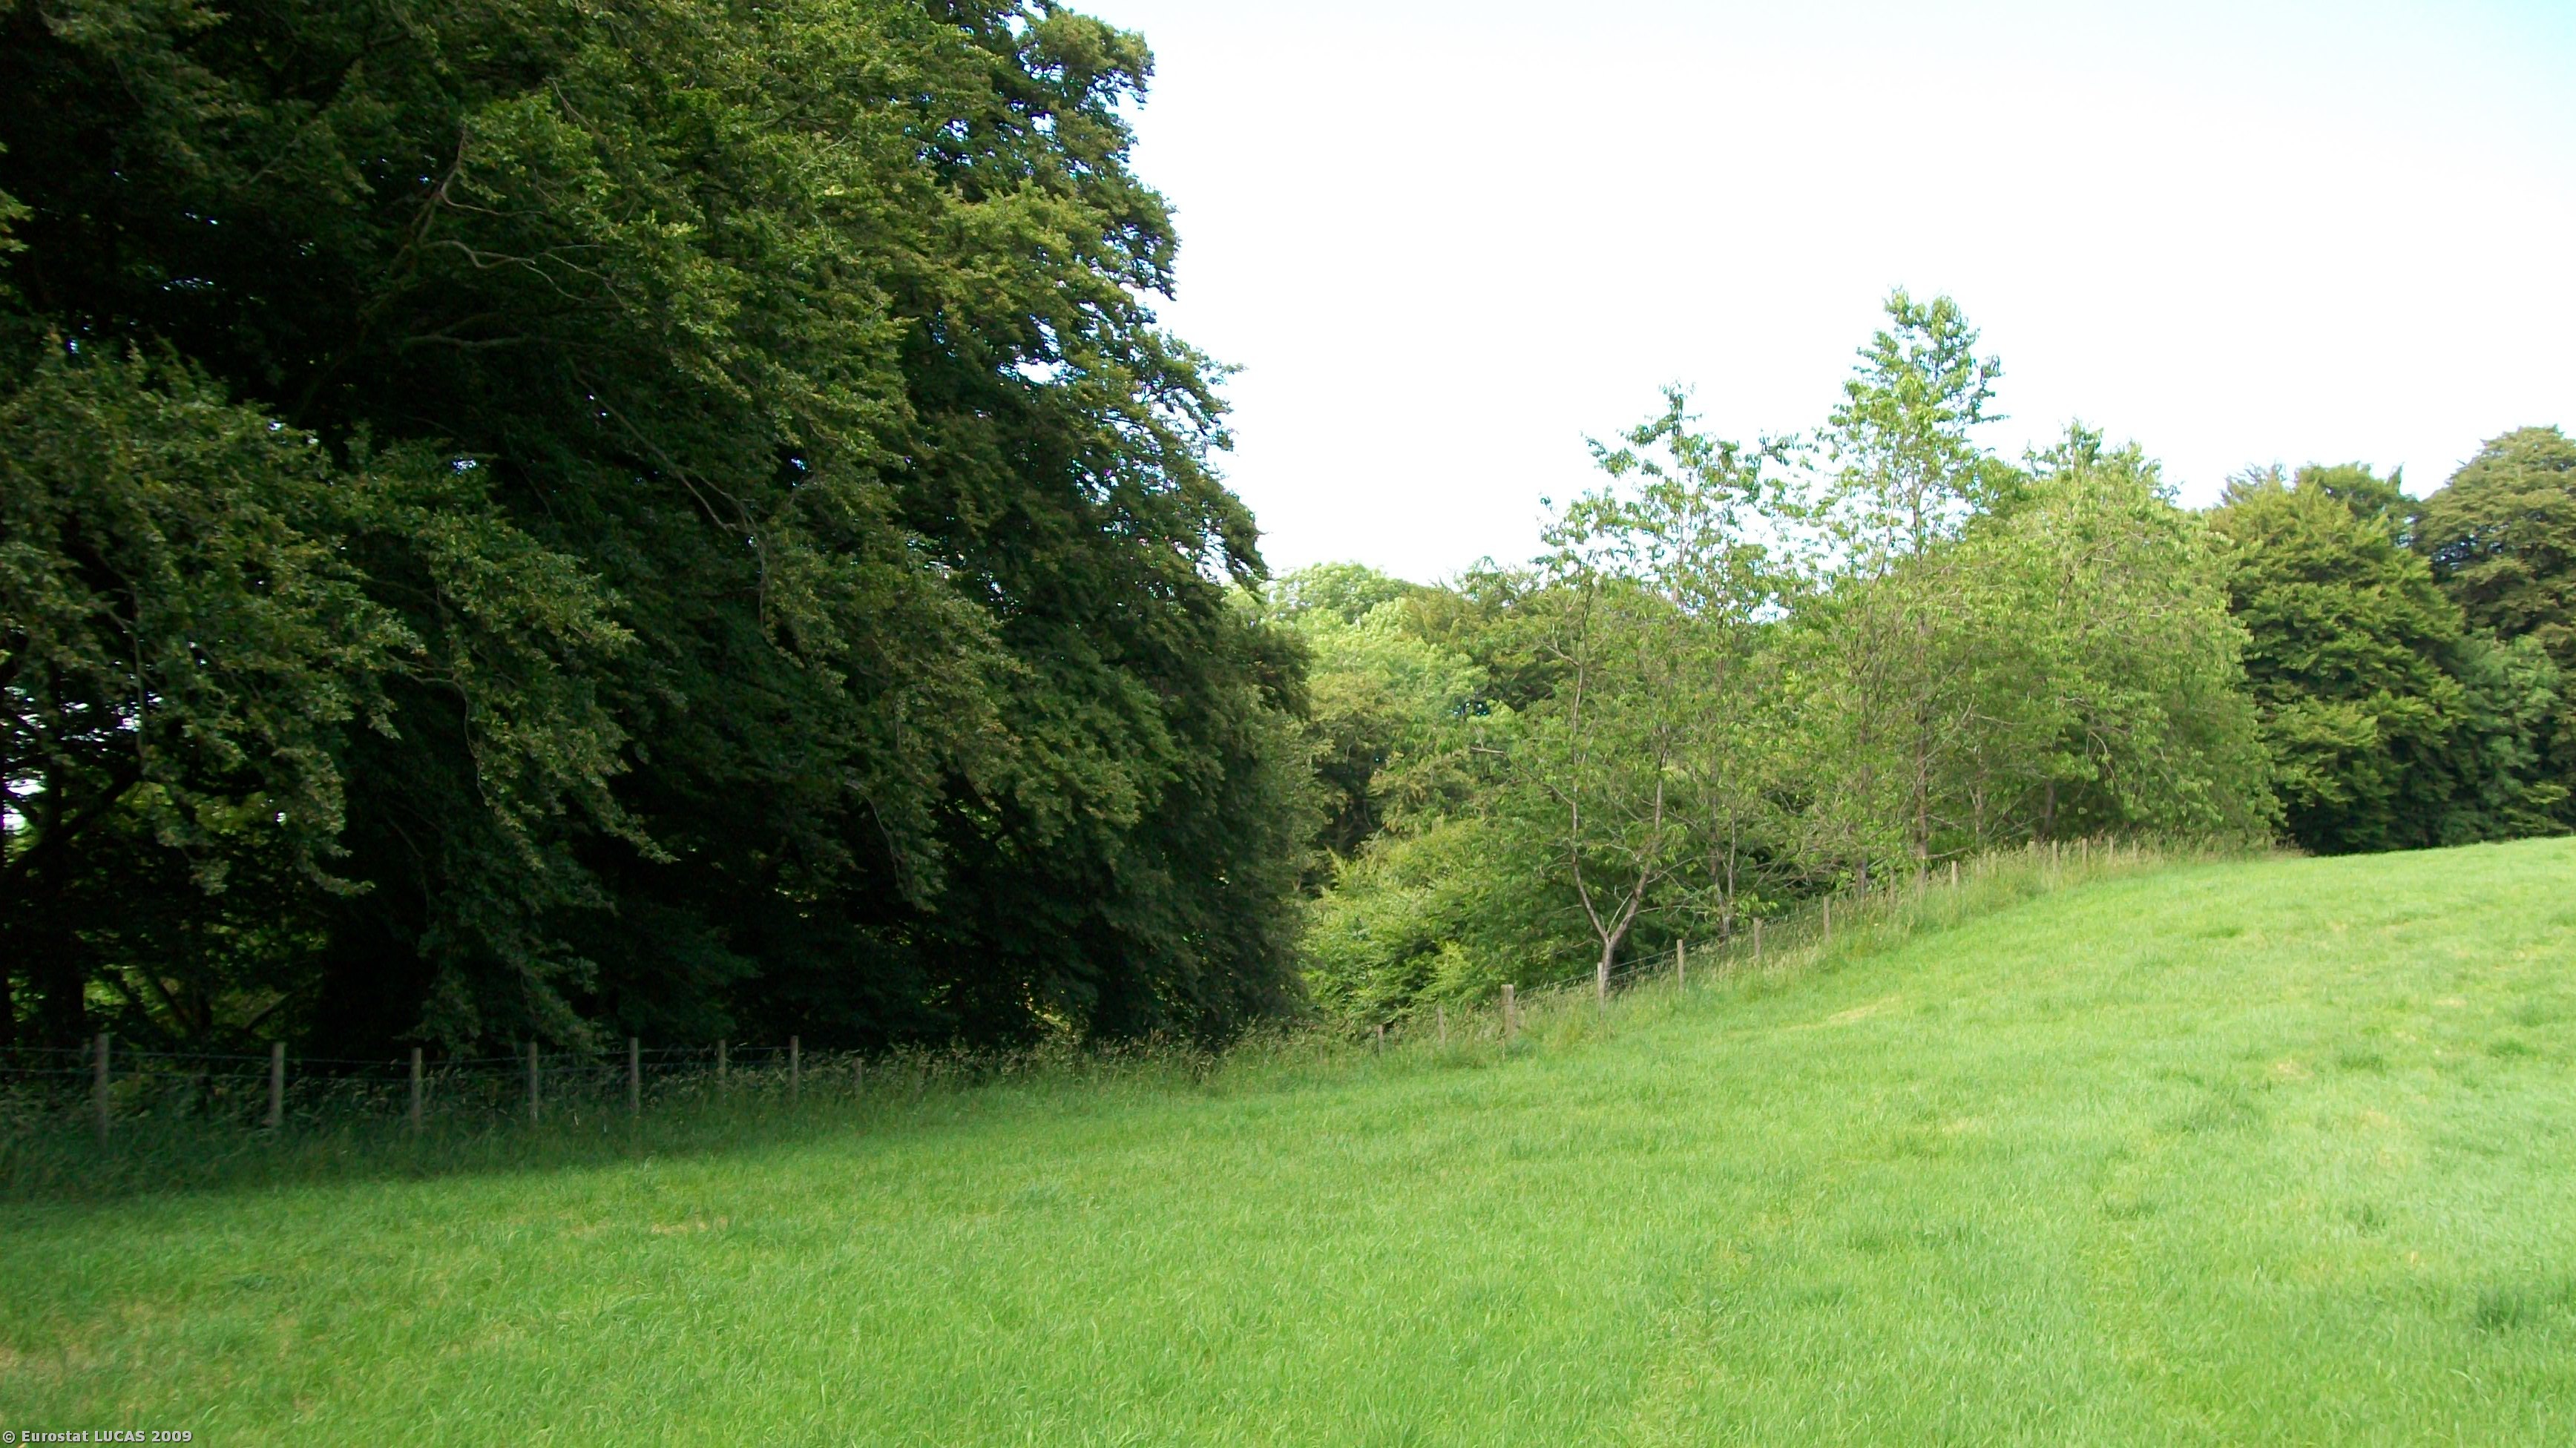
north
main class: Grassland
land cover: Grassland without tree/shrub cover
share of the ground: > 75 %
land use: Agriculture (excluding fallow land and kitchen gardens)
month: July
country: GB
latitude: 55.0030
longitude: -3.9254
